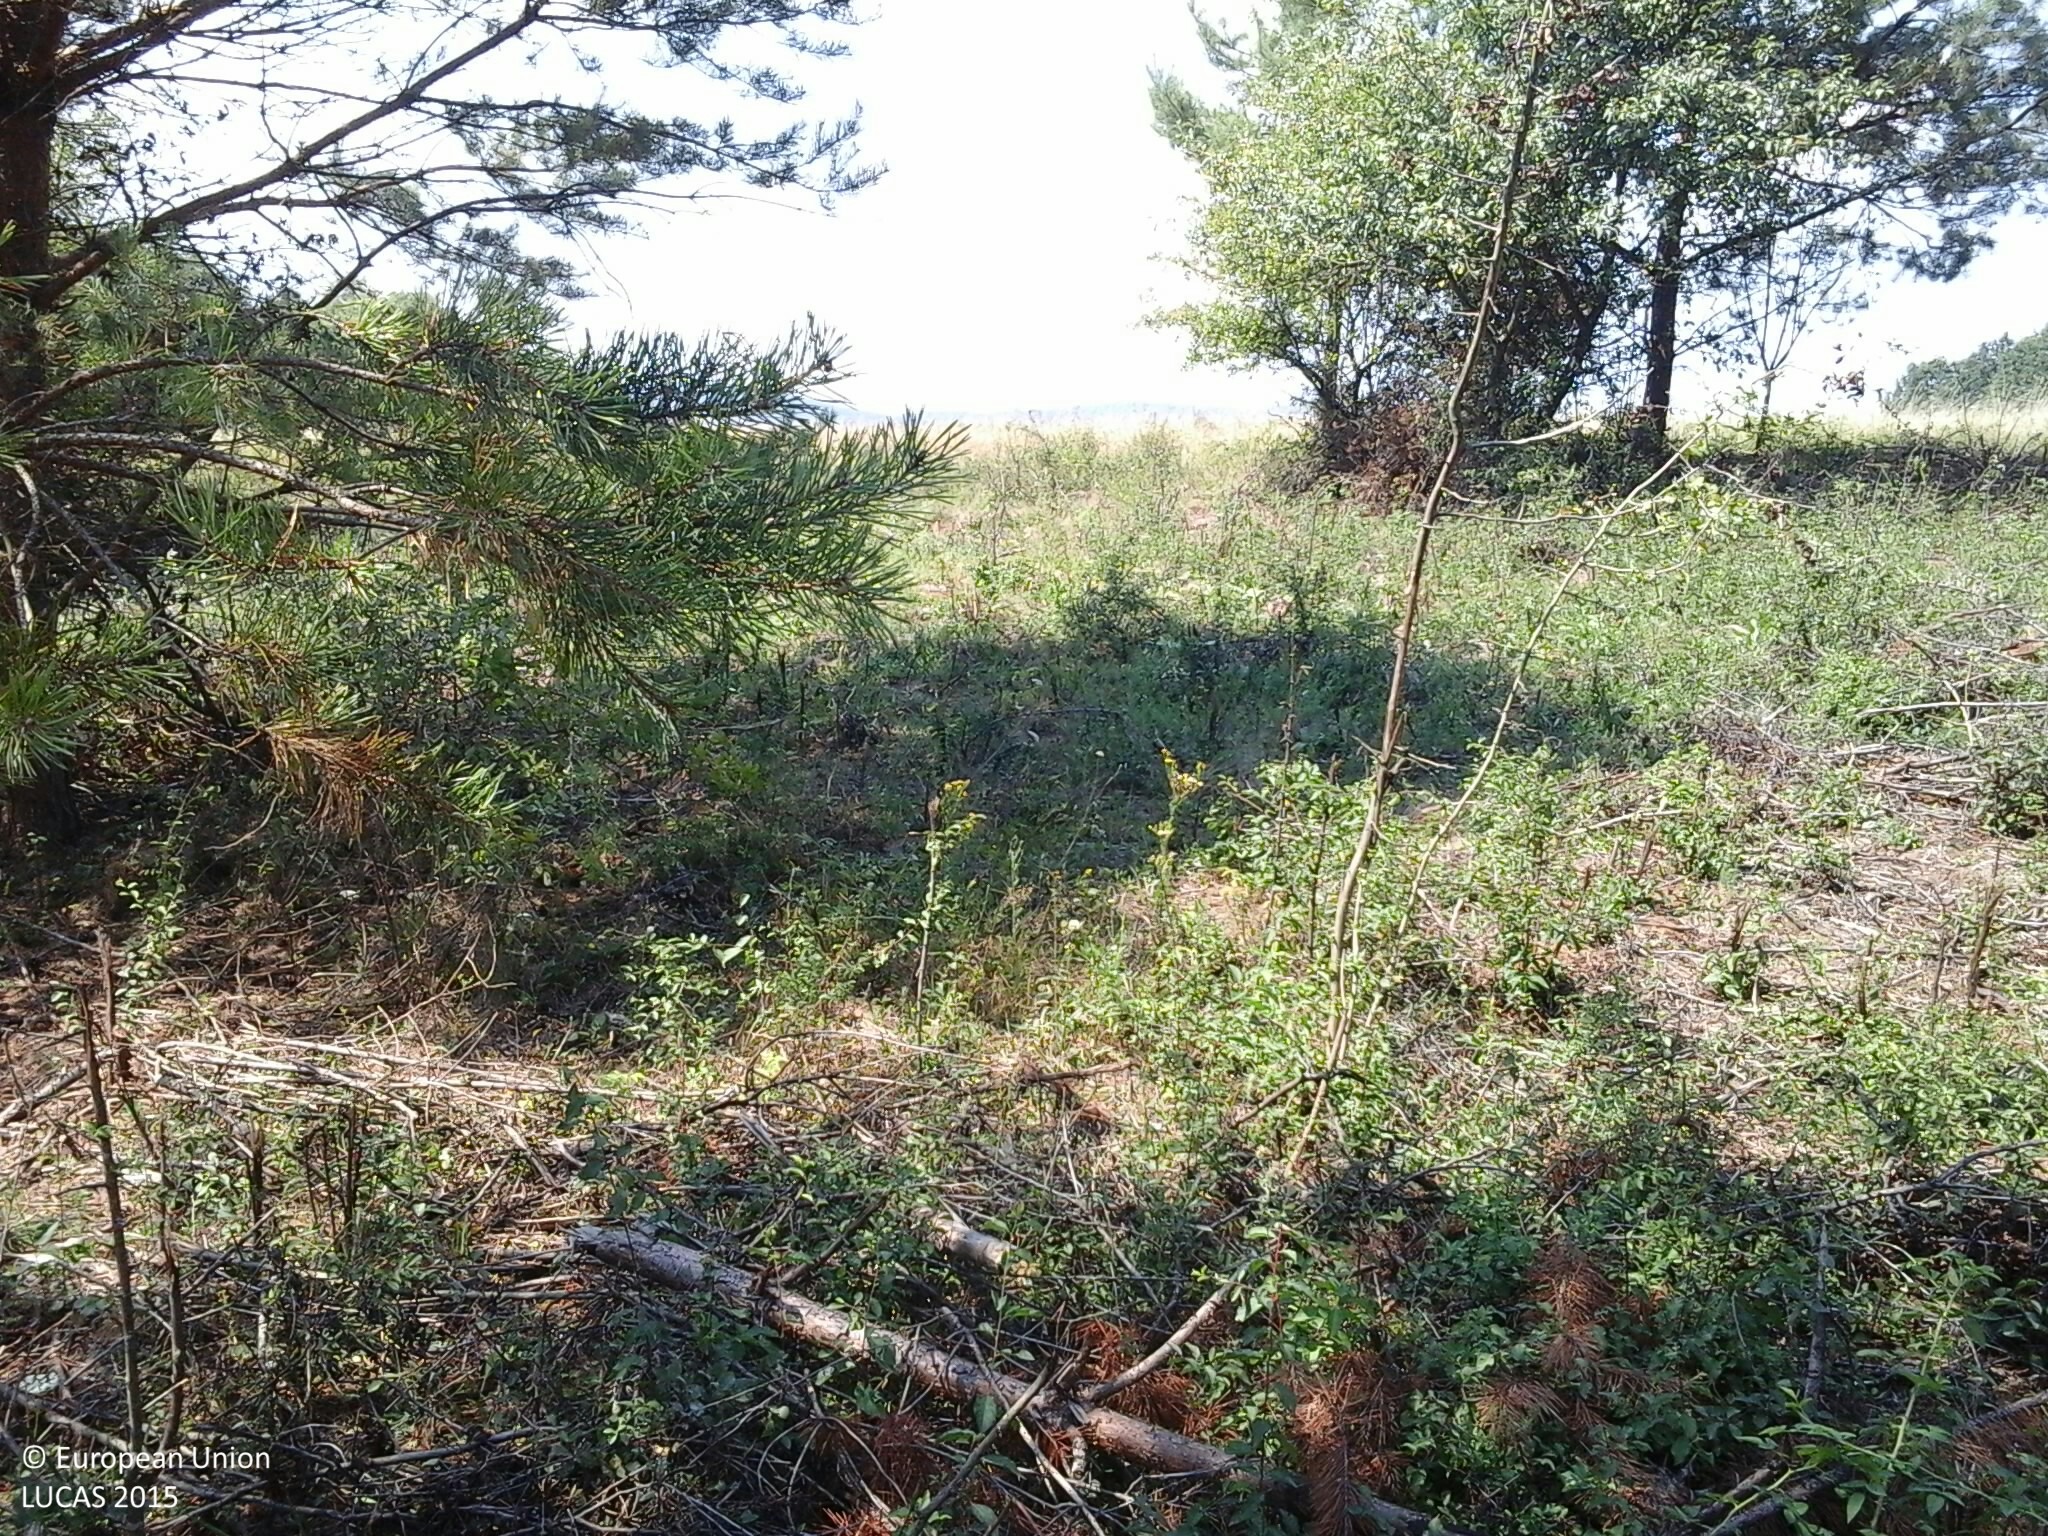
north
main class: Woodland
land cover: Pine dominated mixed woodland
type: hemiboreal forest and nemoral coniferous forest and mixed broadleaved-coniferous forest
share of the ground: > 75 %
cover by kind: herbaceous plants 40 %, shrubs 30 %, coniferous forest trees 15 %, broadleaved forest trees 15 %
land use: Forestry
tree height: > 5 m
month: August
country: HU
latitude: 48.4220
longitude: 20.7533
